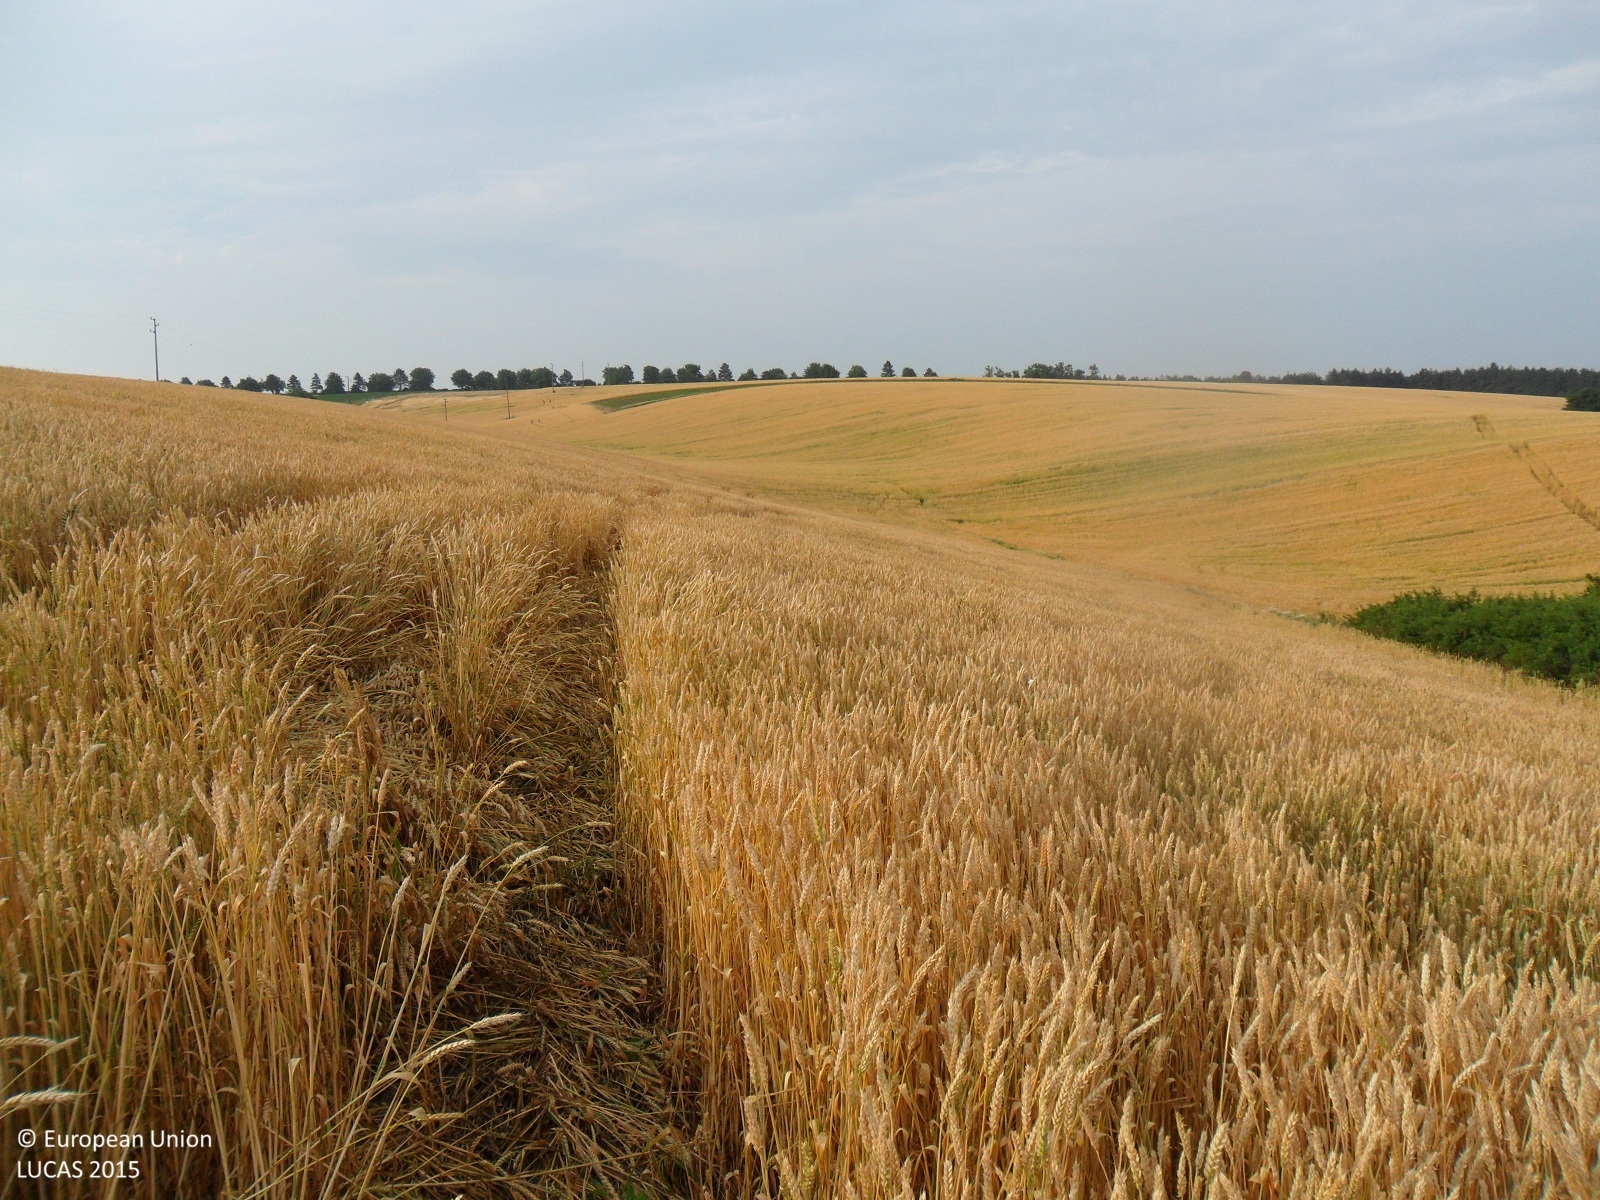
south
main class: Cropland
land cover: Common wheat
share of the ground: > 75 %
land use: Agriculture (excluding fallow land and kitchen gardens)
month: June
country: BG
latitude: 43.7779
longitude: 26.8018
